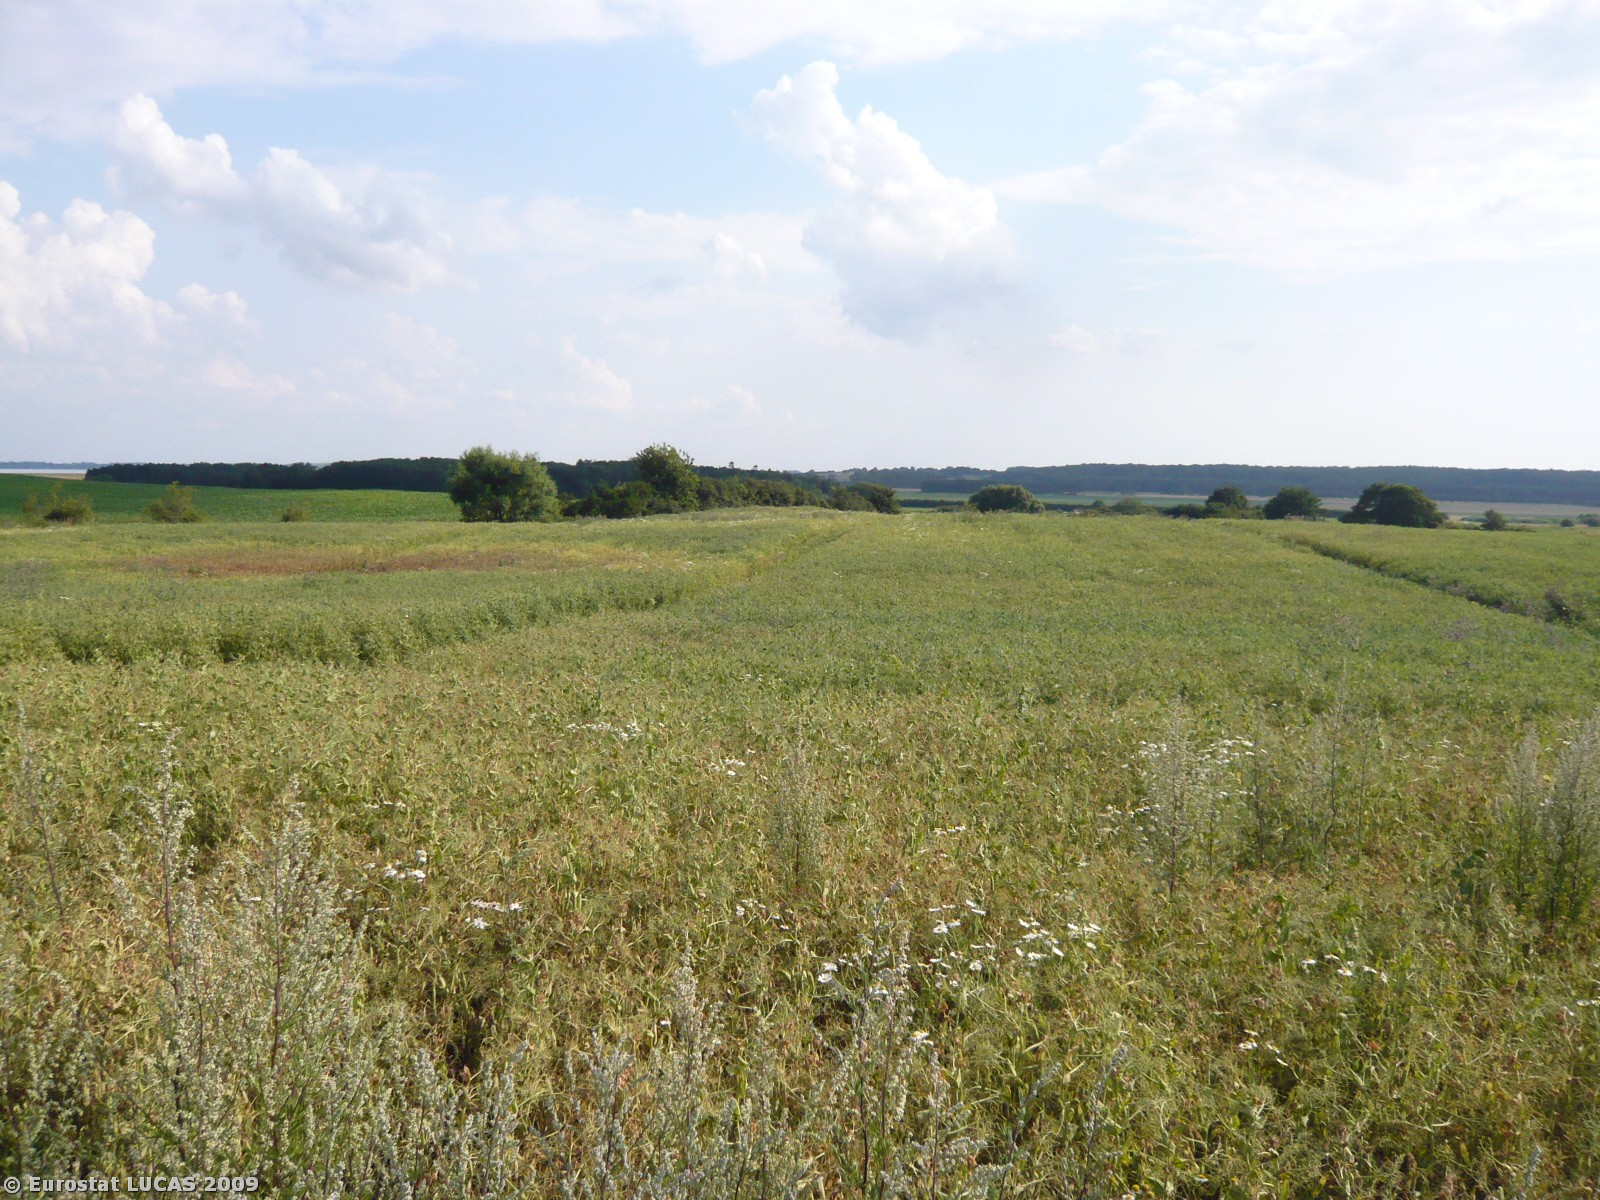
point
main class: Cropland
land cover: Dry pulses
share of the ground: > 75 %
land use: Agriculture (excluding fallow land and kitchen gardens)
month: July
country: DK
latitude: 55.8356
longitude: 11.6430
